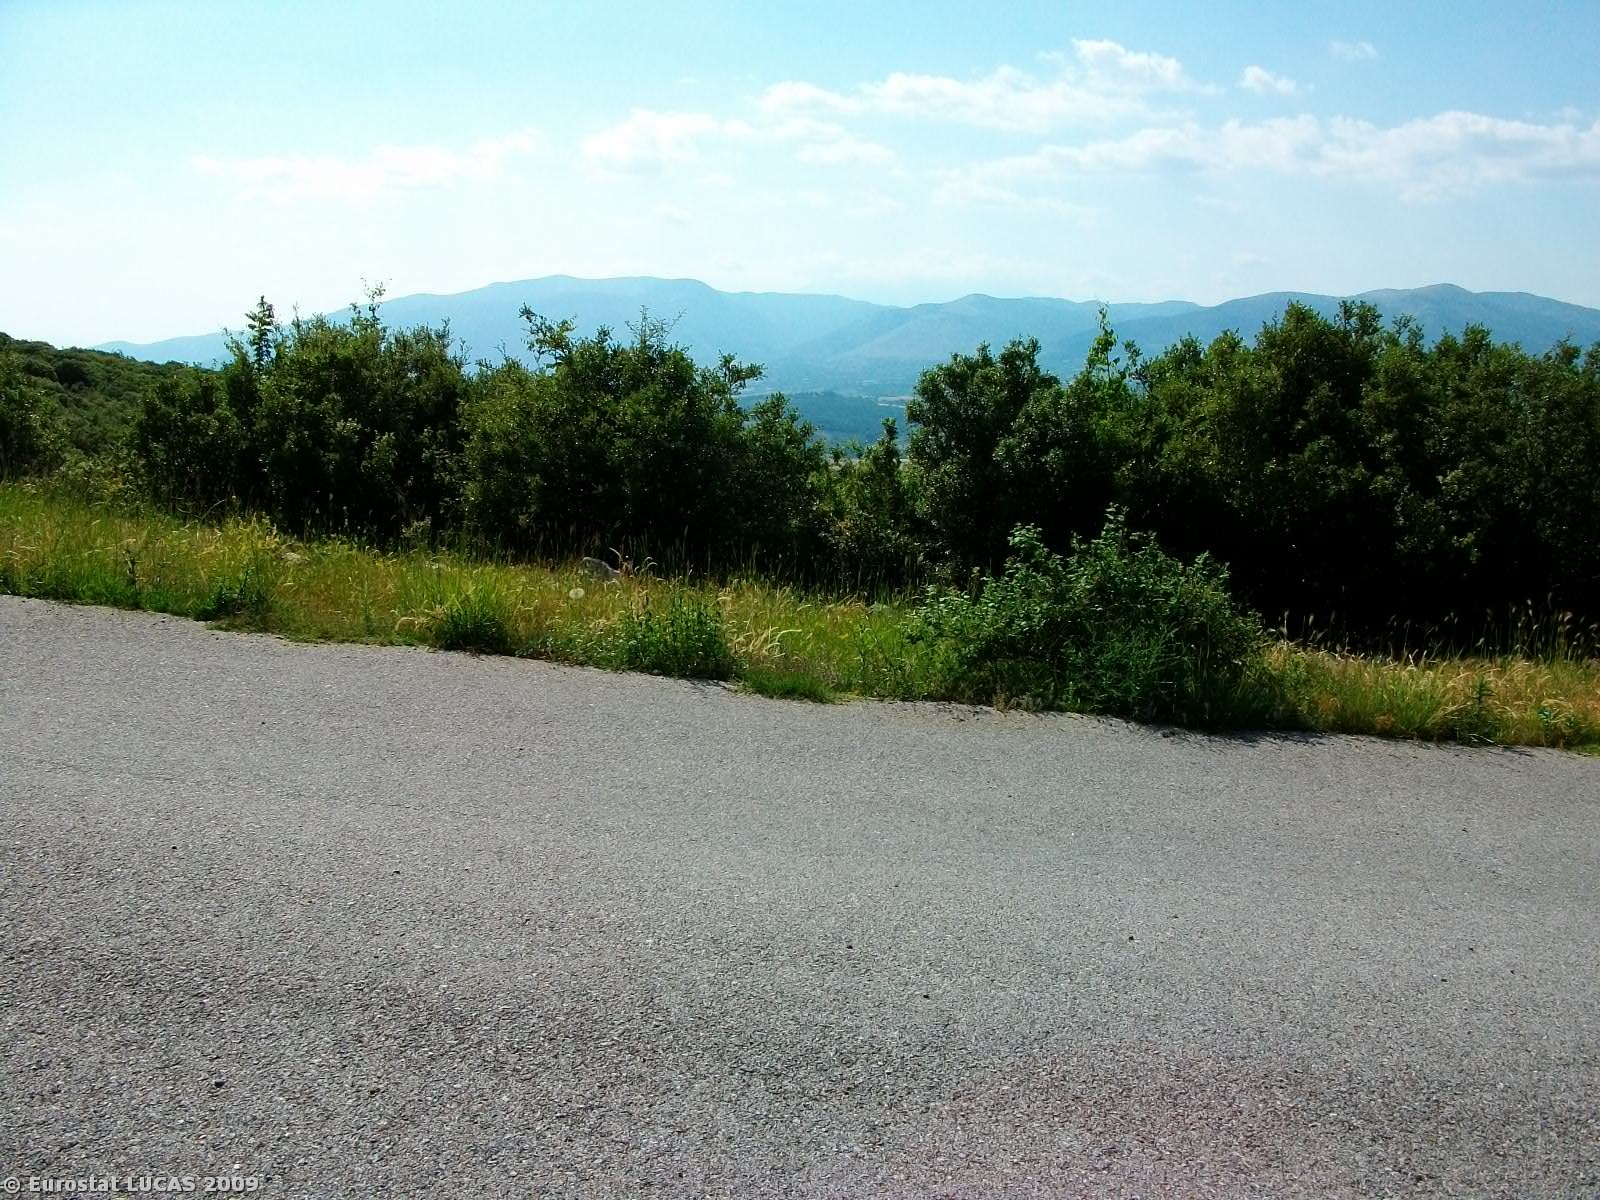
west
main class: Shrubland
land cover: Shrubland with sparse tree cover
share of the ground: > 75 %
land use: Unused
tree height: < 5 m
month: June
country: GR
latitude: 41.1760
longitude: 24.4218
